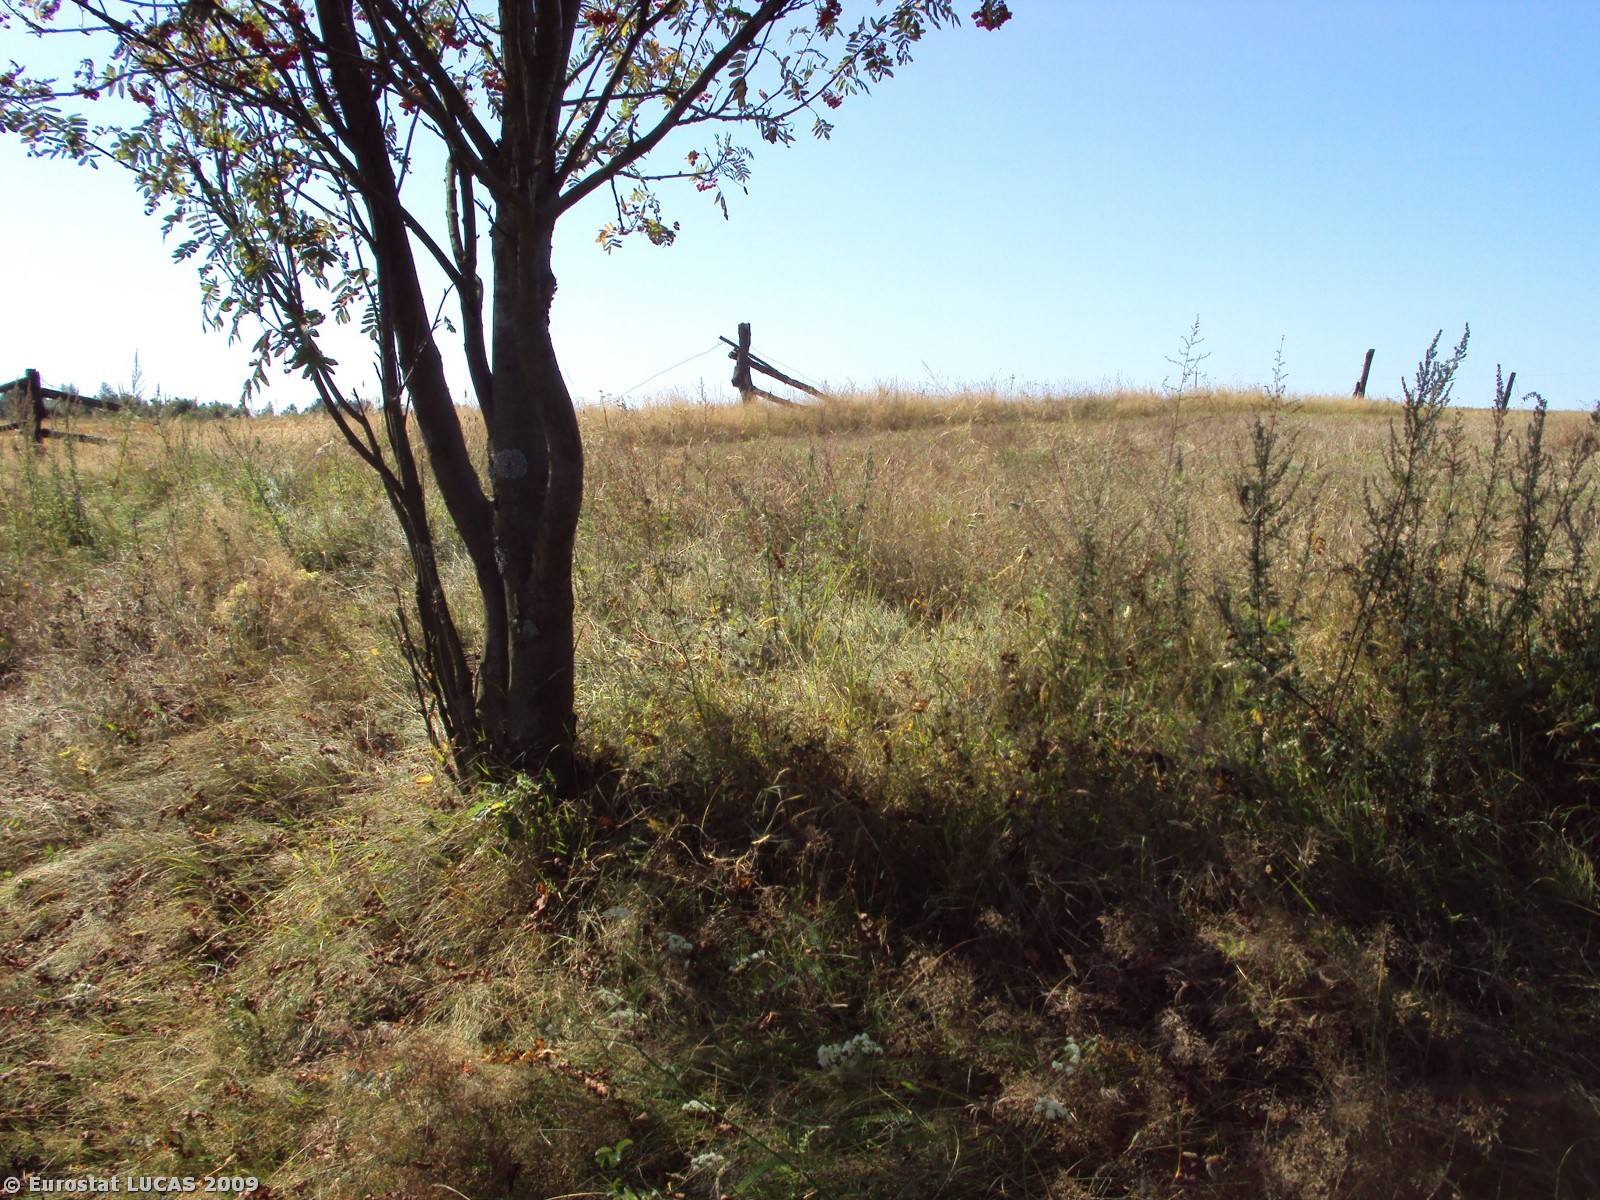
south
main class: Grassland
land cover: Grassland without tree/shrub cover
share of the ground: > 75 %
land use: Agriculture (excluding fallow land and kitchen gardens)
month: August
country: PL
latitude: 53.4877
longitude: 16.3511
